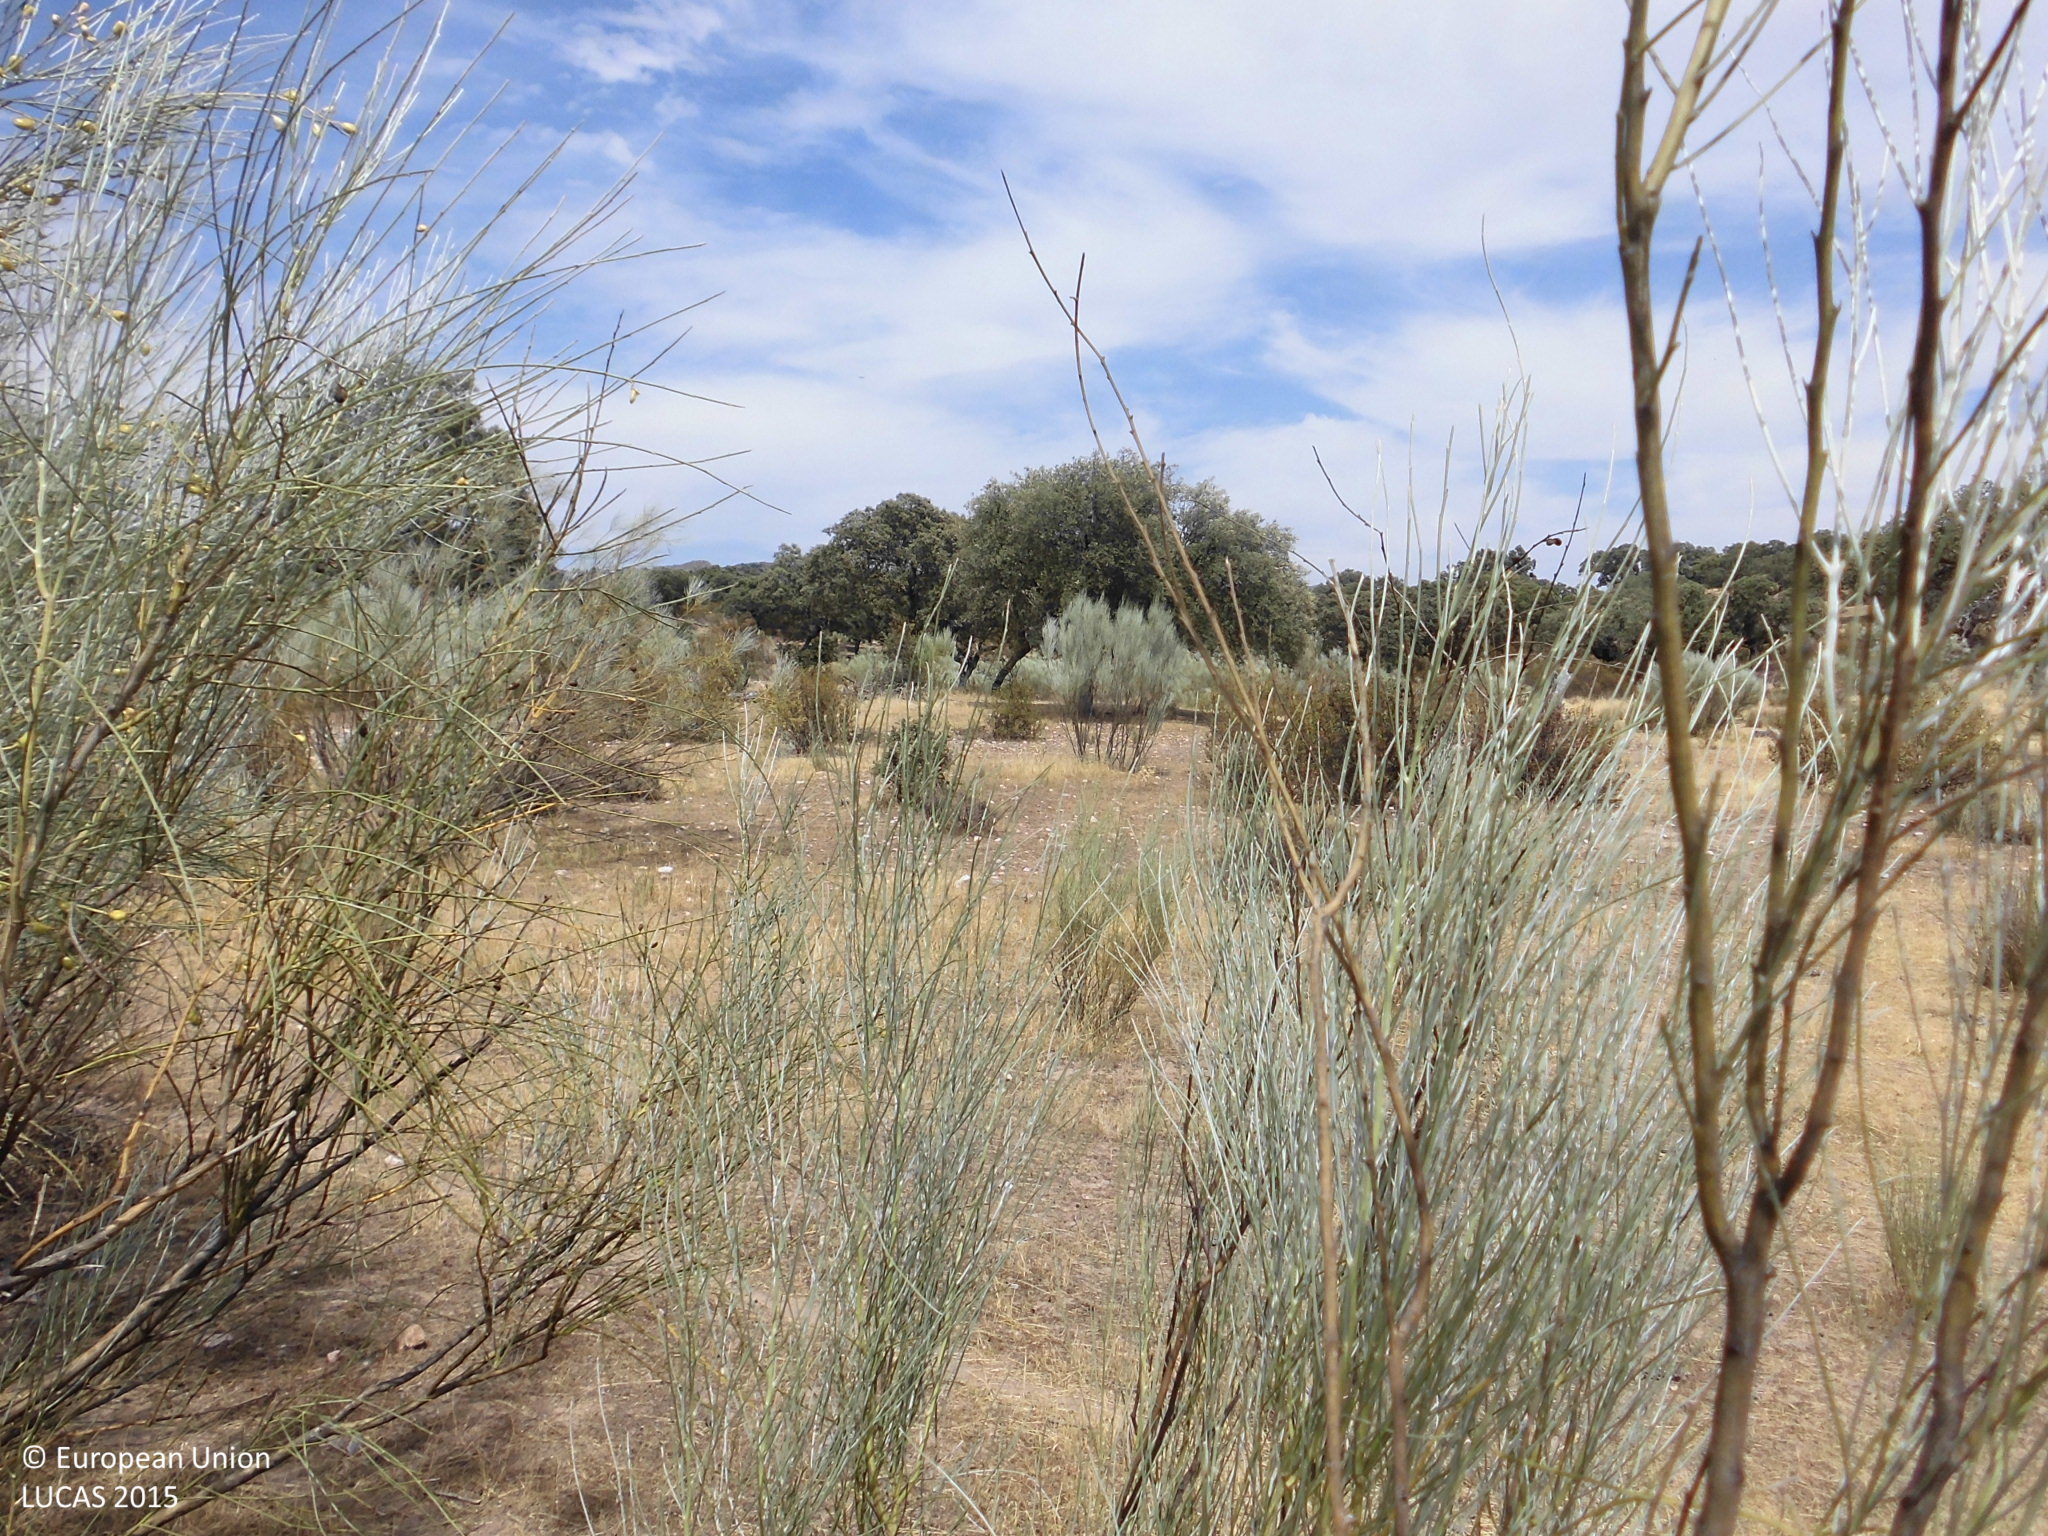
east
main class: Shrubland
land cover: Shrubland with sparse tree cover
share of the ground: 10 - 25 %
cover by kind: herbaceous plants 70 %, shrubs 25 %, broadleaved forest trees 5 %
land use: Agriculture (excluding fallow land and kitchen gardens)
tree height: > 5 m
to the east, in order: Shrubland with sparse tree cover; Broadleaved woodland; Grassland without tree/shrub cover; Rivers and streams; Broadleaved woodland; Tracks; Broadleaved woodland
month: July
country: ES
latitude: 39.8013
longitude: -6.4855
